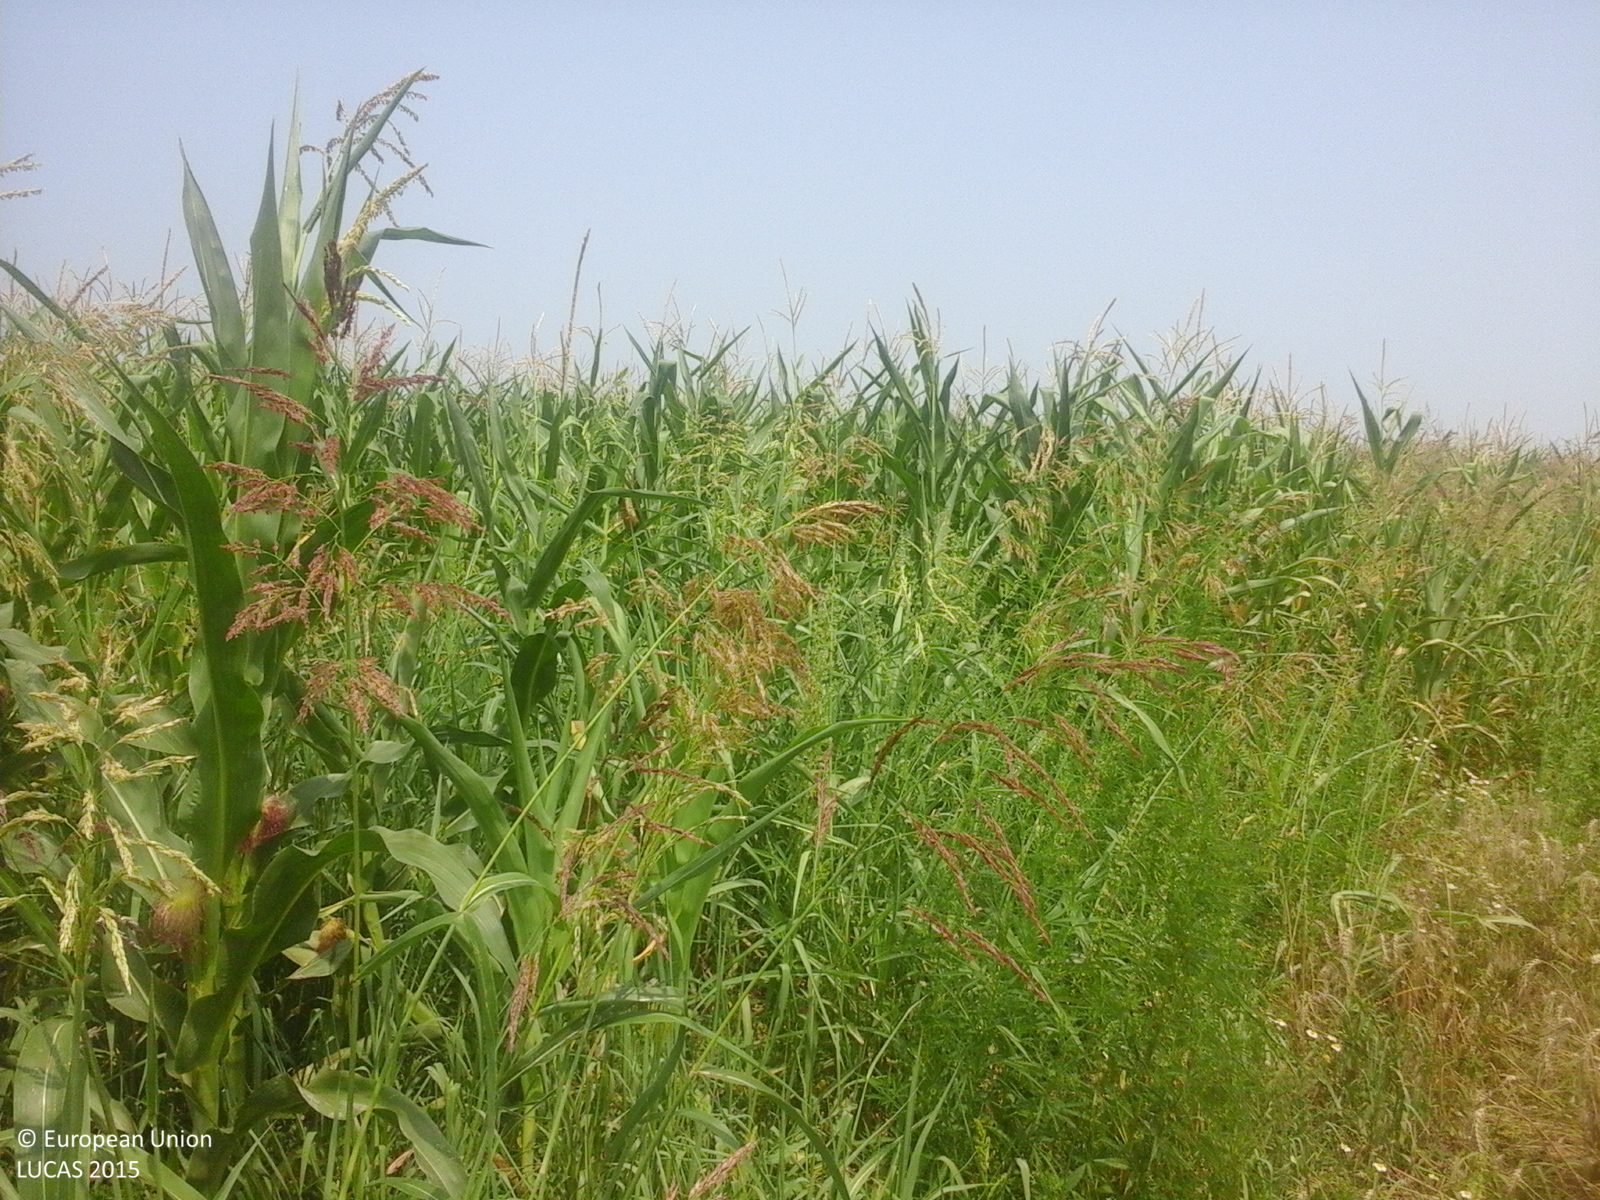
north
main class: Cropland
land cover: Maize
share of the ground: > 75 %
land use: Agriculture (excluding fallow land and kitchen gardens)
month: July
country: RO
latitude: 44.7637
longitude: 26.5049
